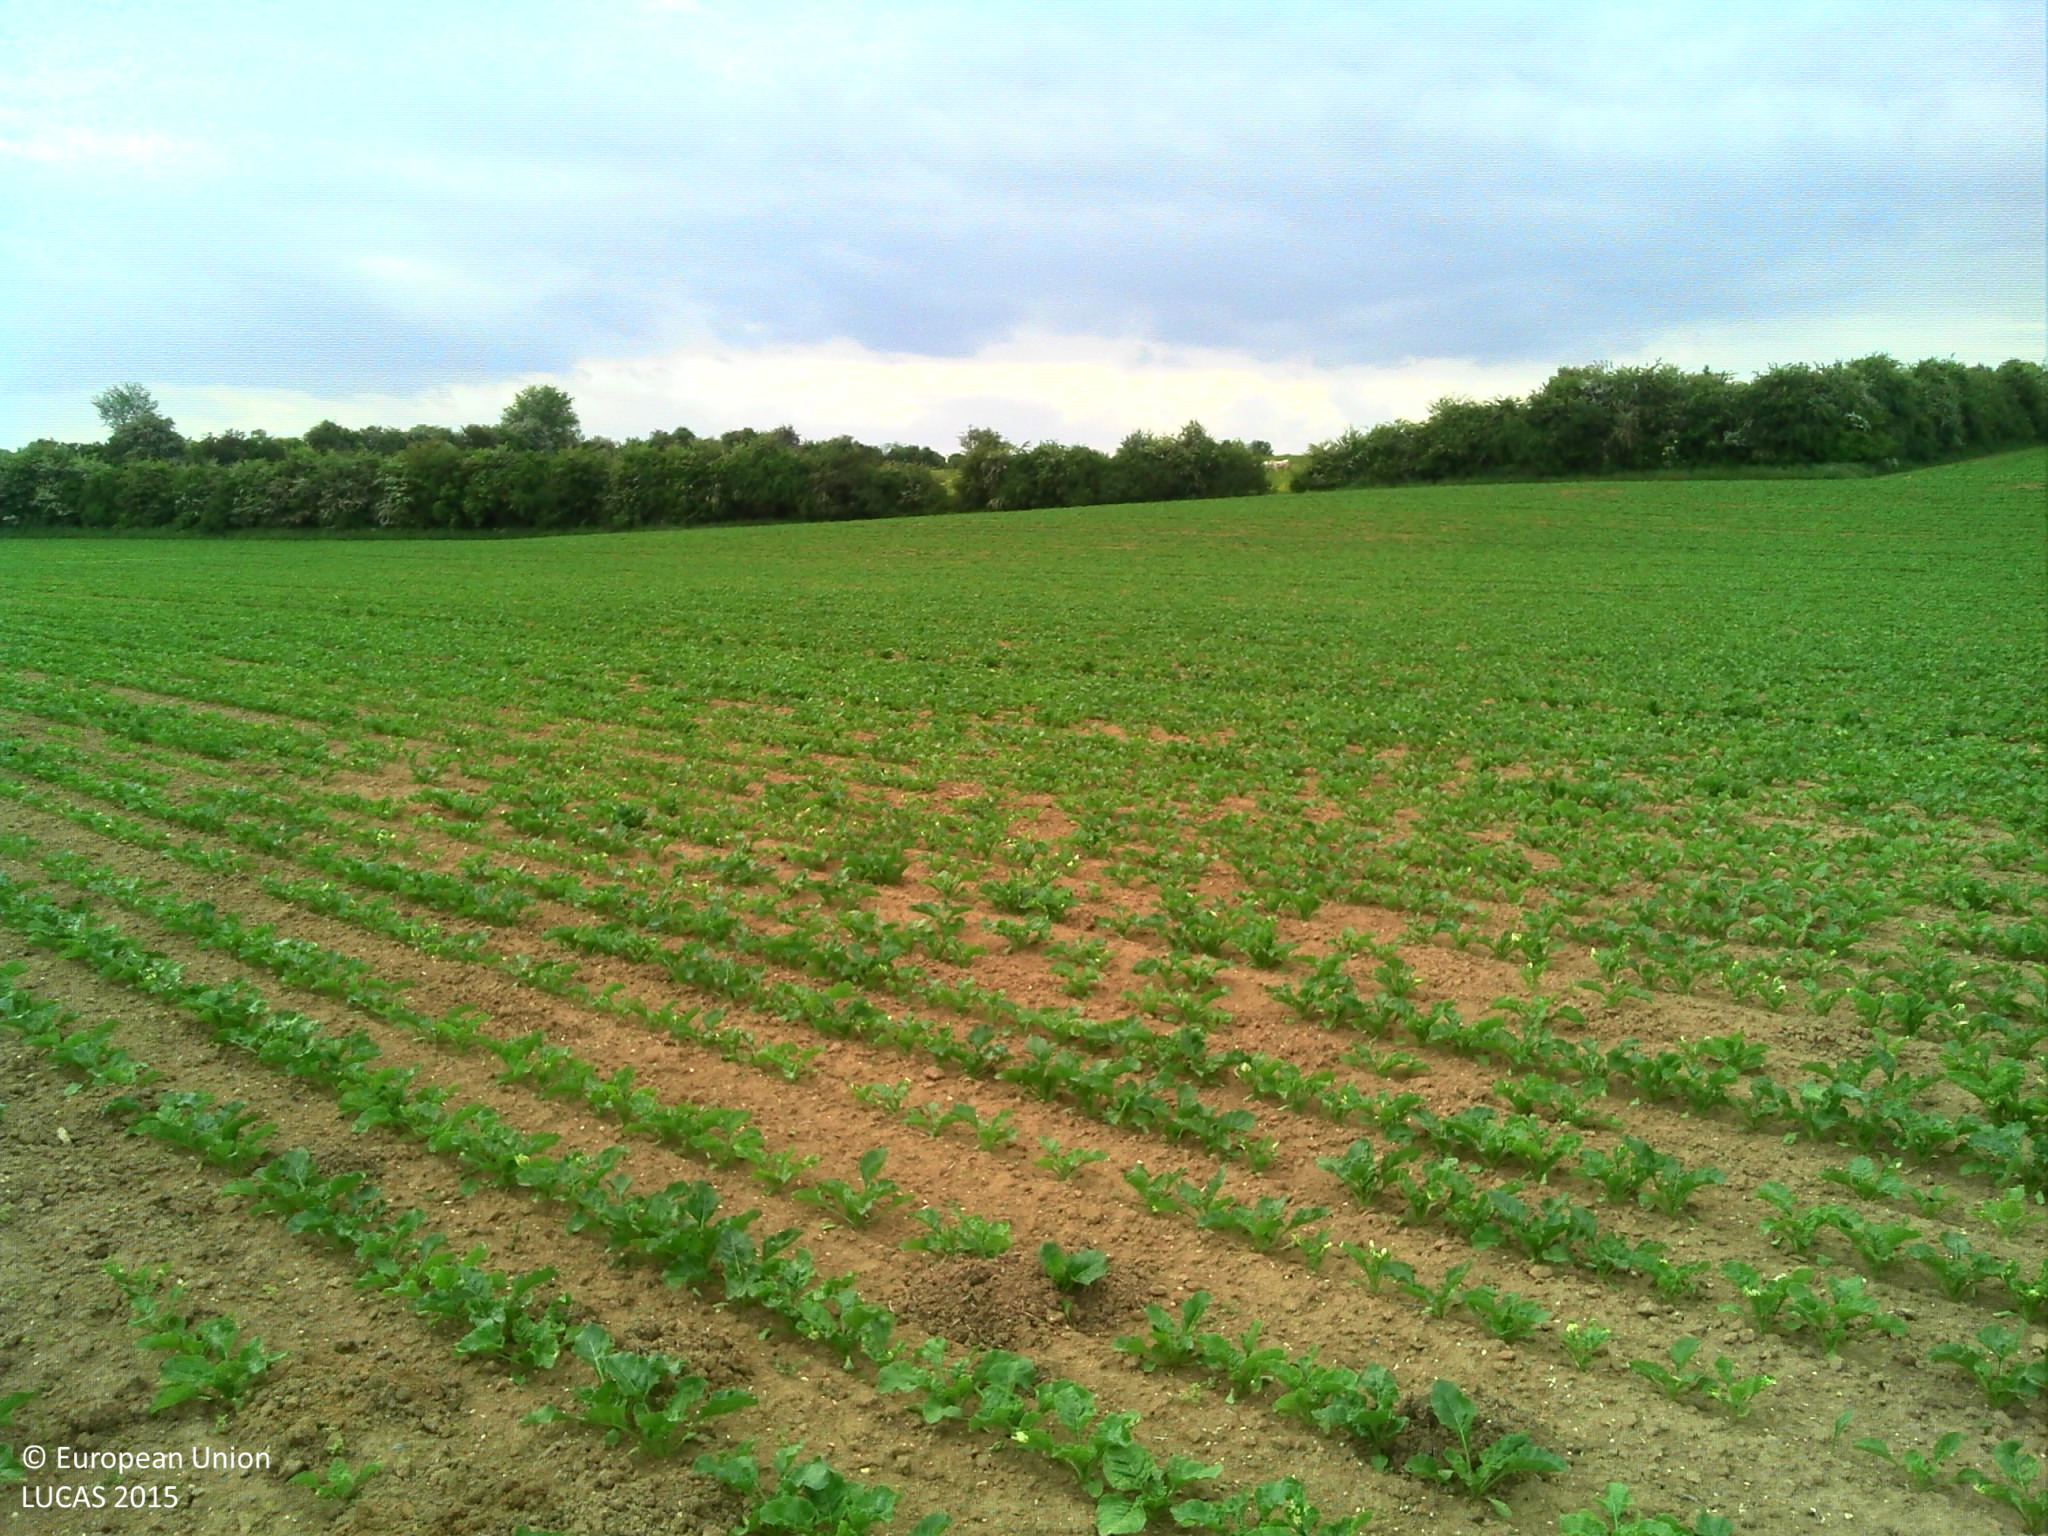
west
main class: Cropland
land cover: Sugar beet
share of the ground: > 75 %
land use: Agriculture (excluding fallow land and kitchen gardens)
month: May
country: FR
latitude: 49.9649
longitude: 3.2300
